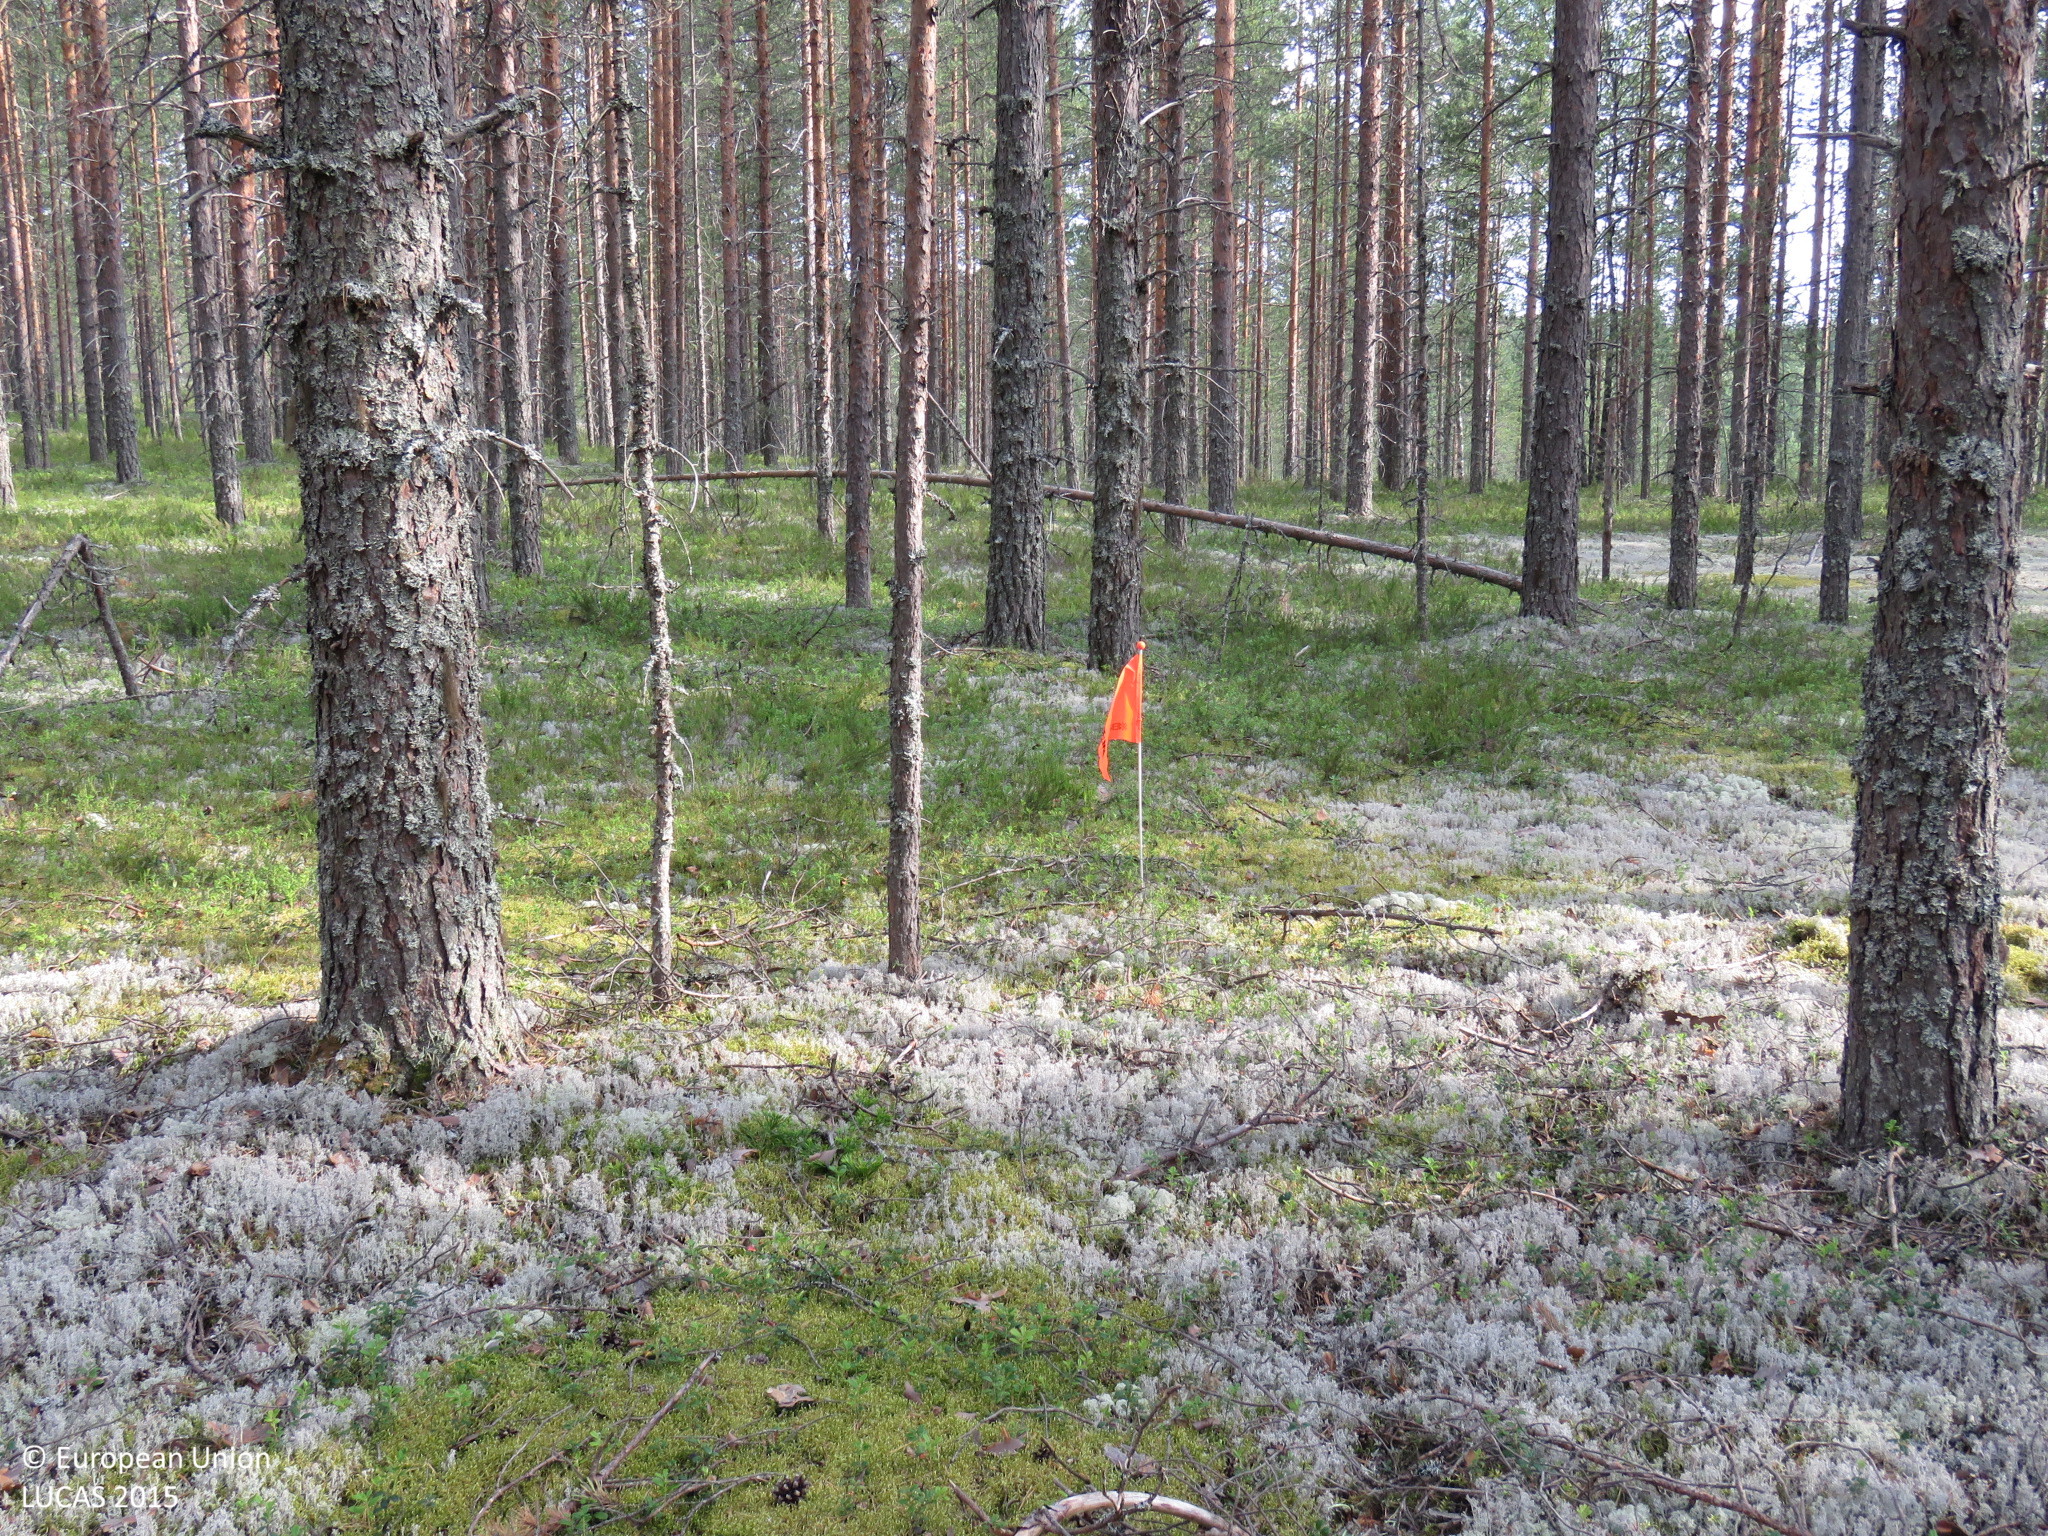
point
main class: Woodland
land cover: Pine dominated coniferous woodland
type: boreal forest
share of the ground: > 75 %
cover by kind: coniferous forest trees 80 %, shrubs 10 %, lichens and mosses 10 %
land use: Amenities, museums, leisure
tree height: > 5 m
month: July
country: FI
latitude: 64.5860
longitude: 26.4648
